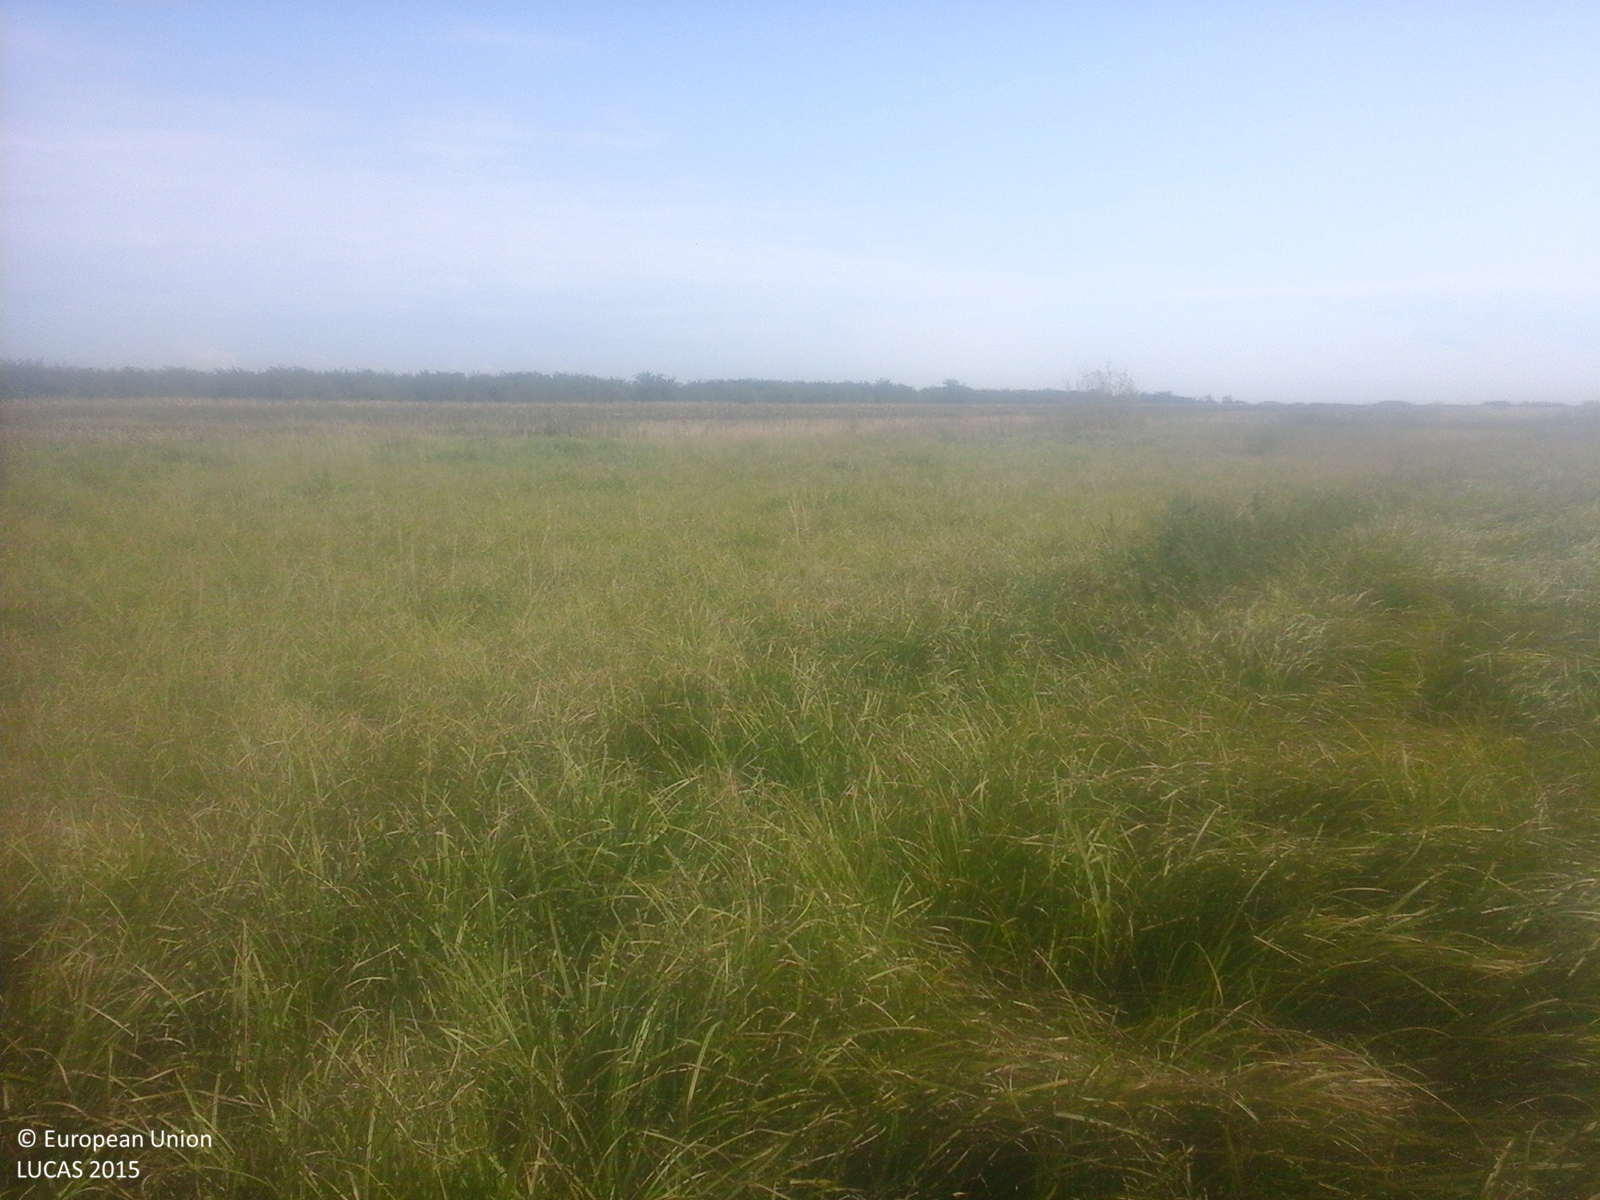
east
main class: Grassland
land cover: Spontaneously vegetated surfaces
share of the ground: > 75 %
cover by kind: herbaceous plants 100 %
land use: Fallow land
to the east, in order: Spontaneously vegetated surfaces; Ditches and canals; Durum wheat; Ditches and canals; Spontaneously vegetated surfaces; Other fruit trees and berries; Spontaneously vegetated surfaces
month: September
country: RO
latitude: 47.7538
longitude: 22.5854
